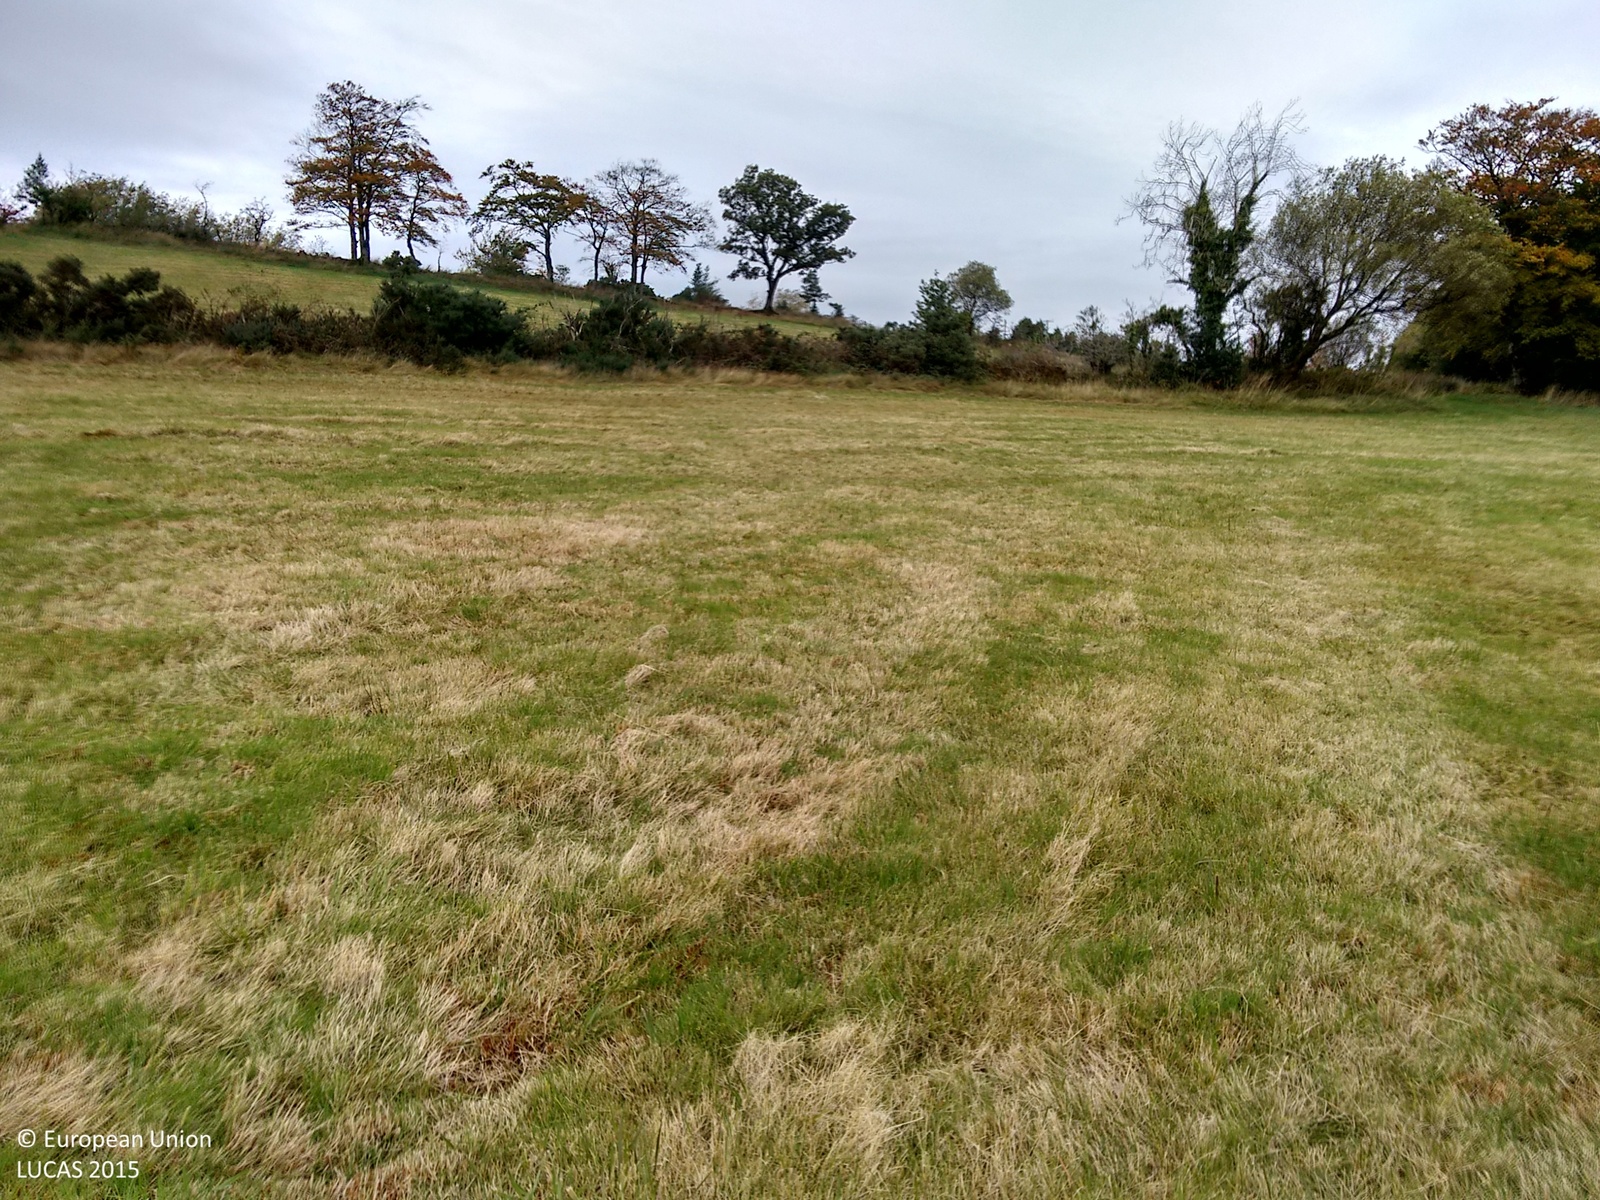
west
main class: Grassland
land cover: Grassland without tree/shrub cover
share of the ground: > 75 %
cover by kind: herbaceous plants 100 %
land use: Agriculture (excluding fallow land and kitchen gardens)
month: October
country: GB
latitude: 54.2660
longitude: -7.3952
